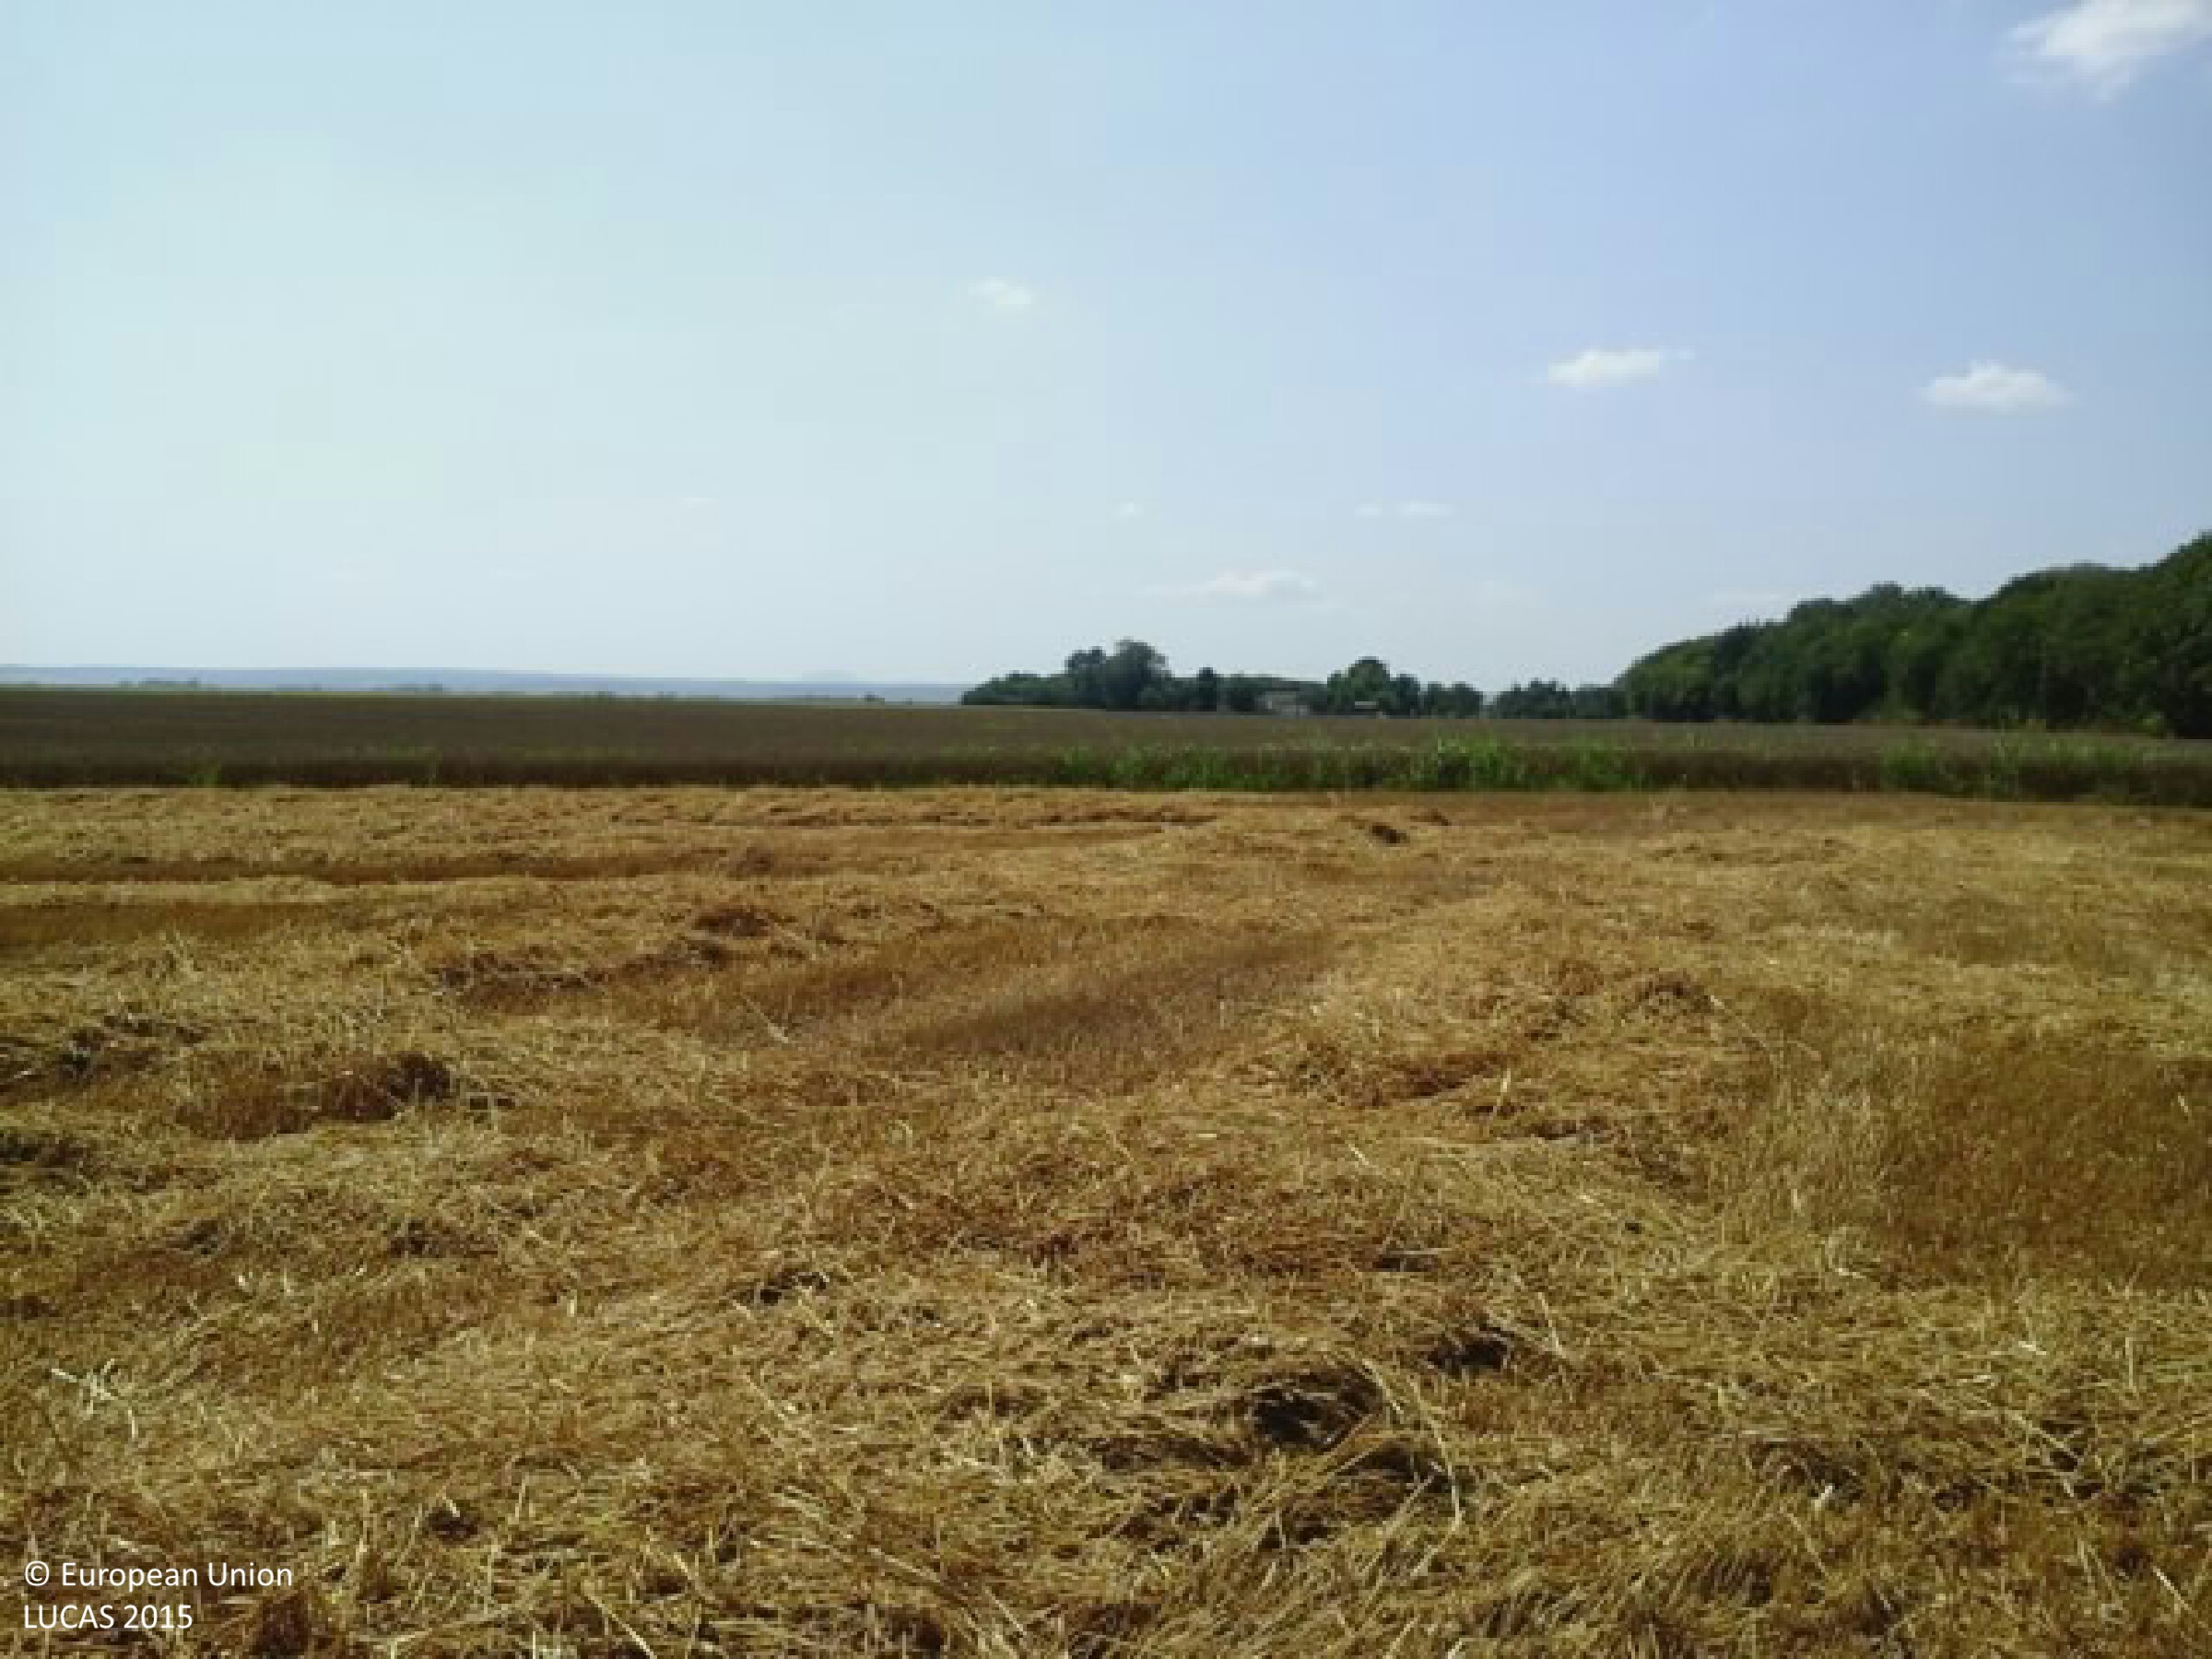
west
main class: Cropland
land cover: Common wheat
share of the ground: 50 - 75 %
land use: Agriculture (excluding fallow land and kitchen gardens)
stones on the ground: < 10 %
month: July
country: HU
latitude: 46.2580
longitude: 18.8200
